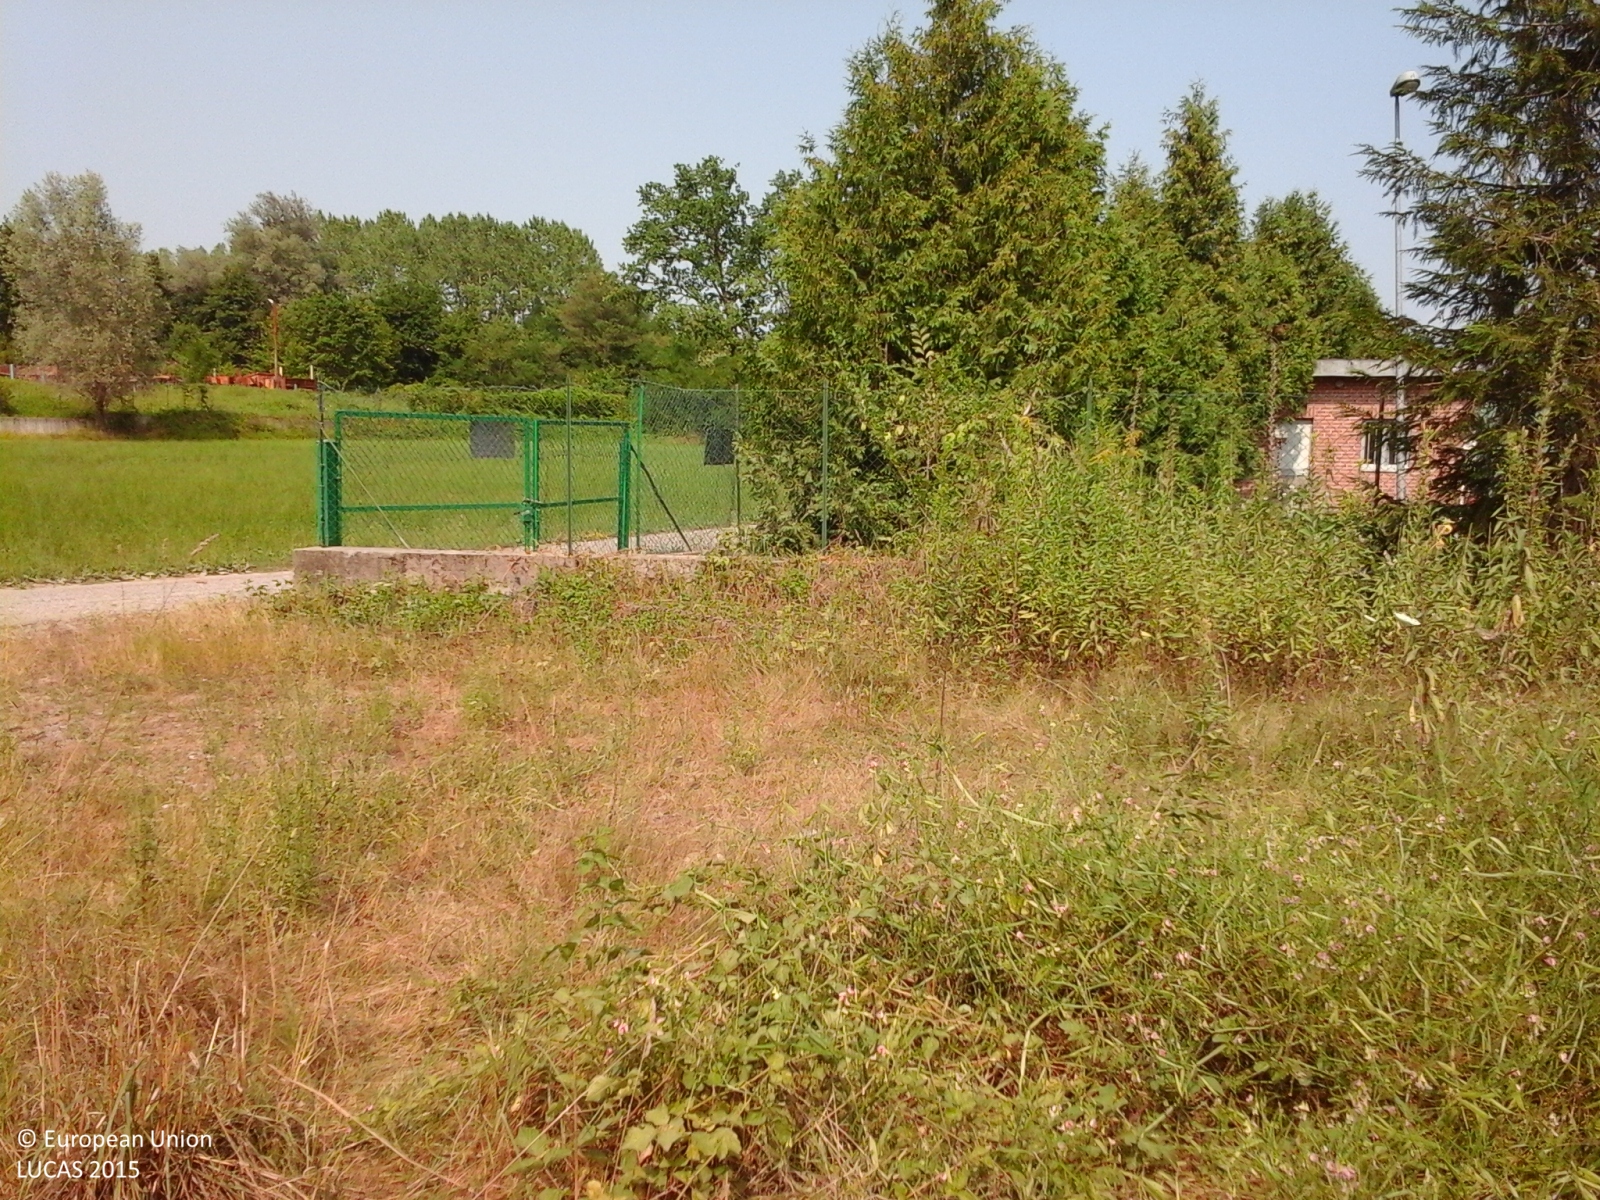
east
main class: Woodland
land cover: Broadleaved woodland
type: floodplain forest
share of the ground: > 75 %
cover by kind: broadleaved forest trees 100 %
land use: Semi-natural and natural areas not in use
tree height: > 5 m
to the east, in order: Broadleaved woodland; Ditches and canals; Broadleaved woodland; Inland fresh running water; Broadleaved woodland
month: July
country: IT
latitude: 45.2804
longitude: 7.6709
